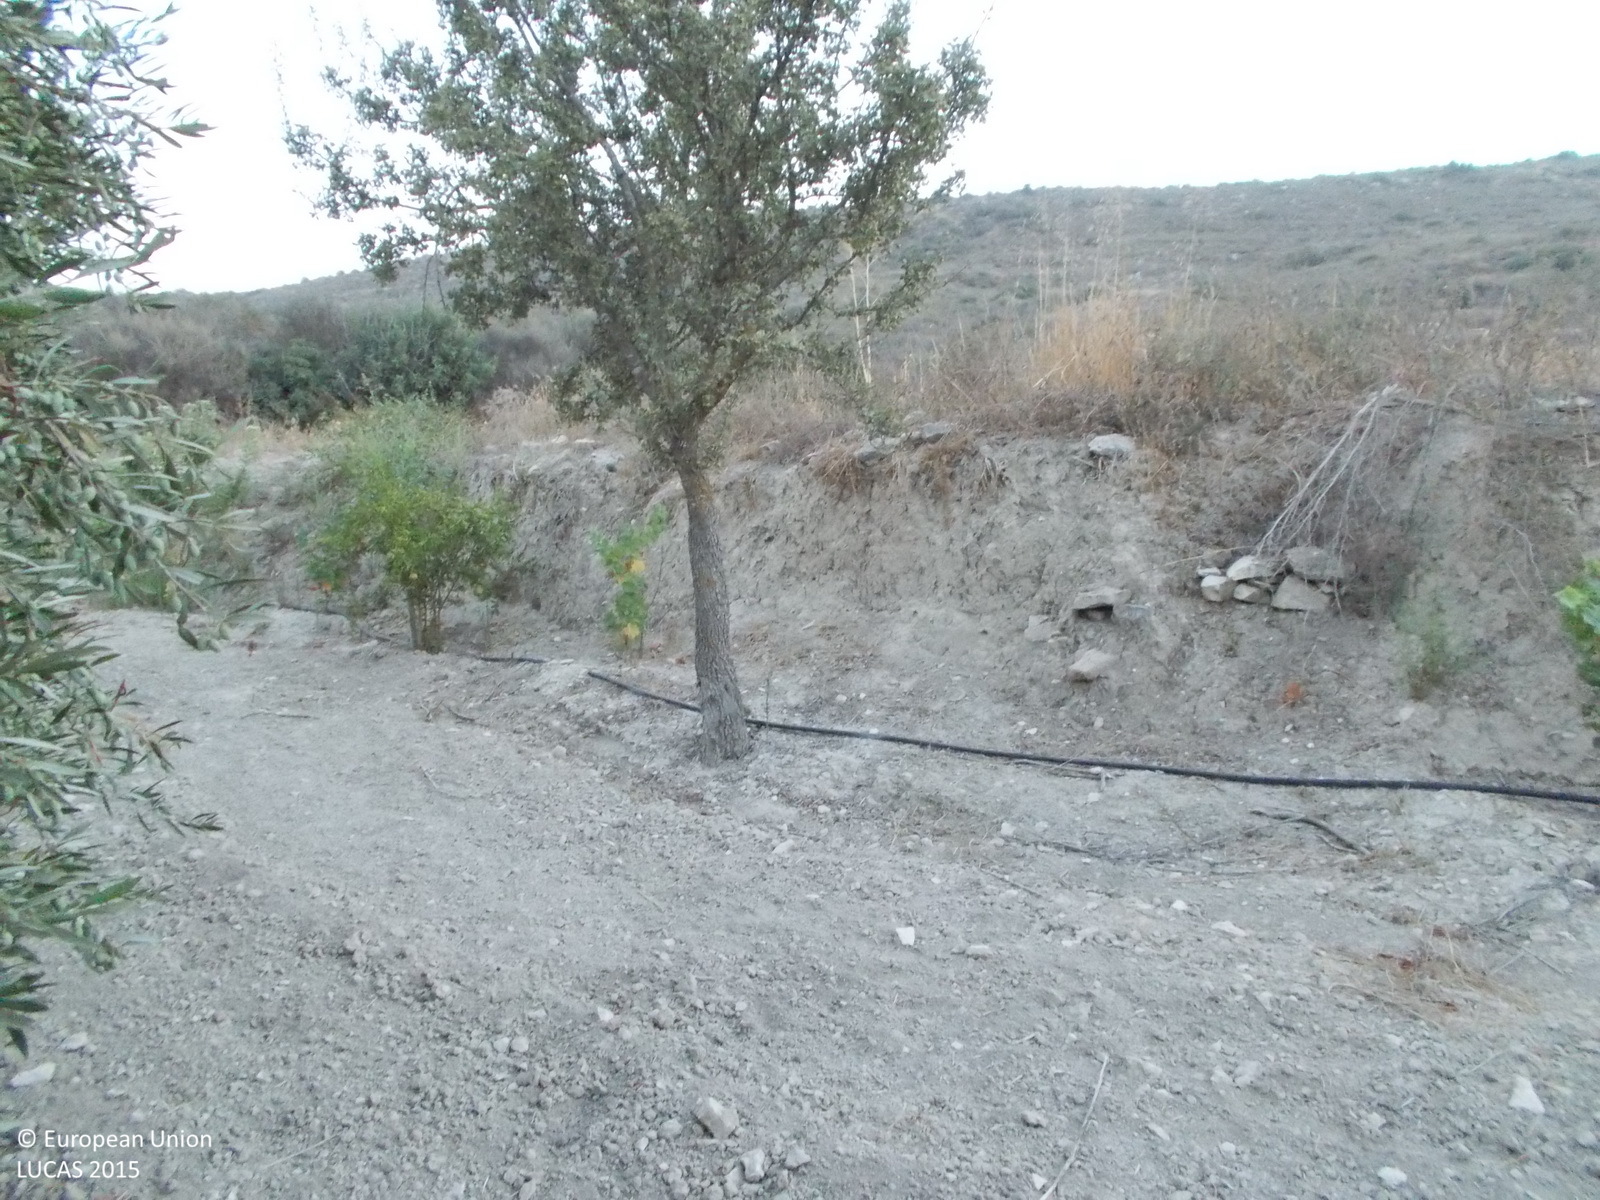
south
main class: Cropland
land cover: Olive groves
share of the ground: > 75 %
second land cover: Other bare soil
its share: > 75 %
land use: Agriculture (excluding fallow land and kitchen gardens)
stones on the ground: < 10 %
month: May
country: CY
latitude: 34.7879
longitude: 33.3150
